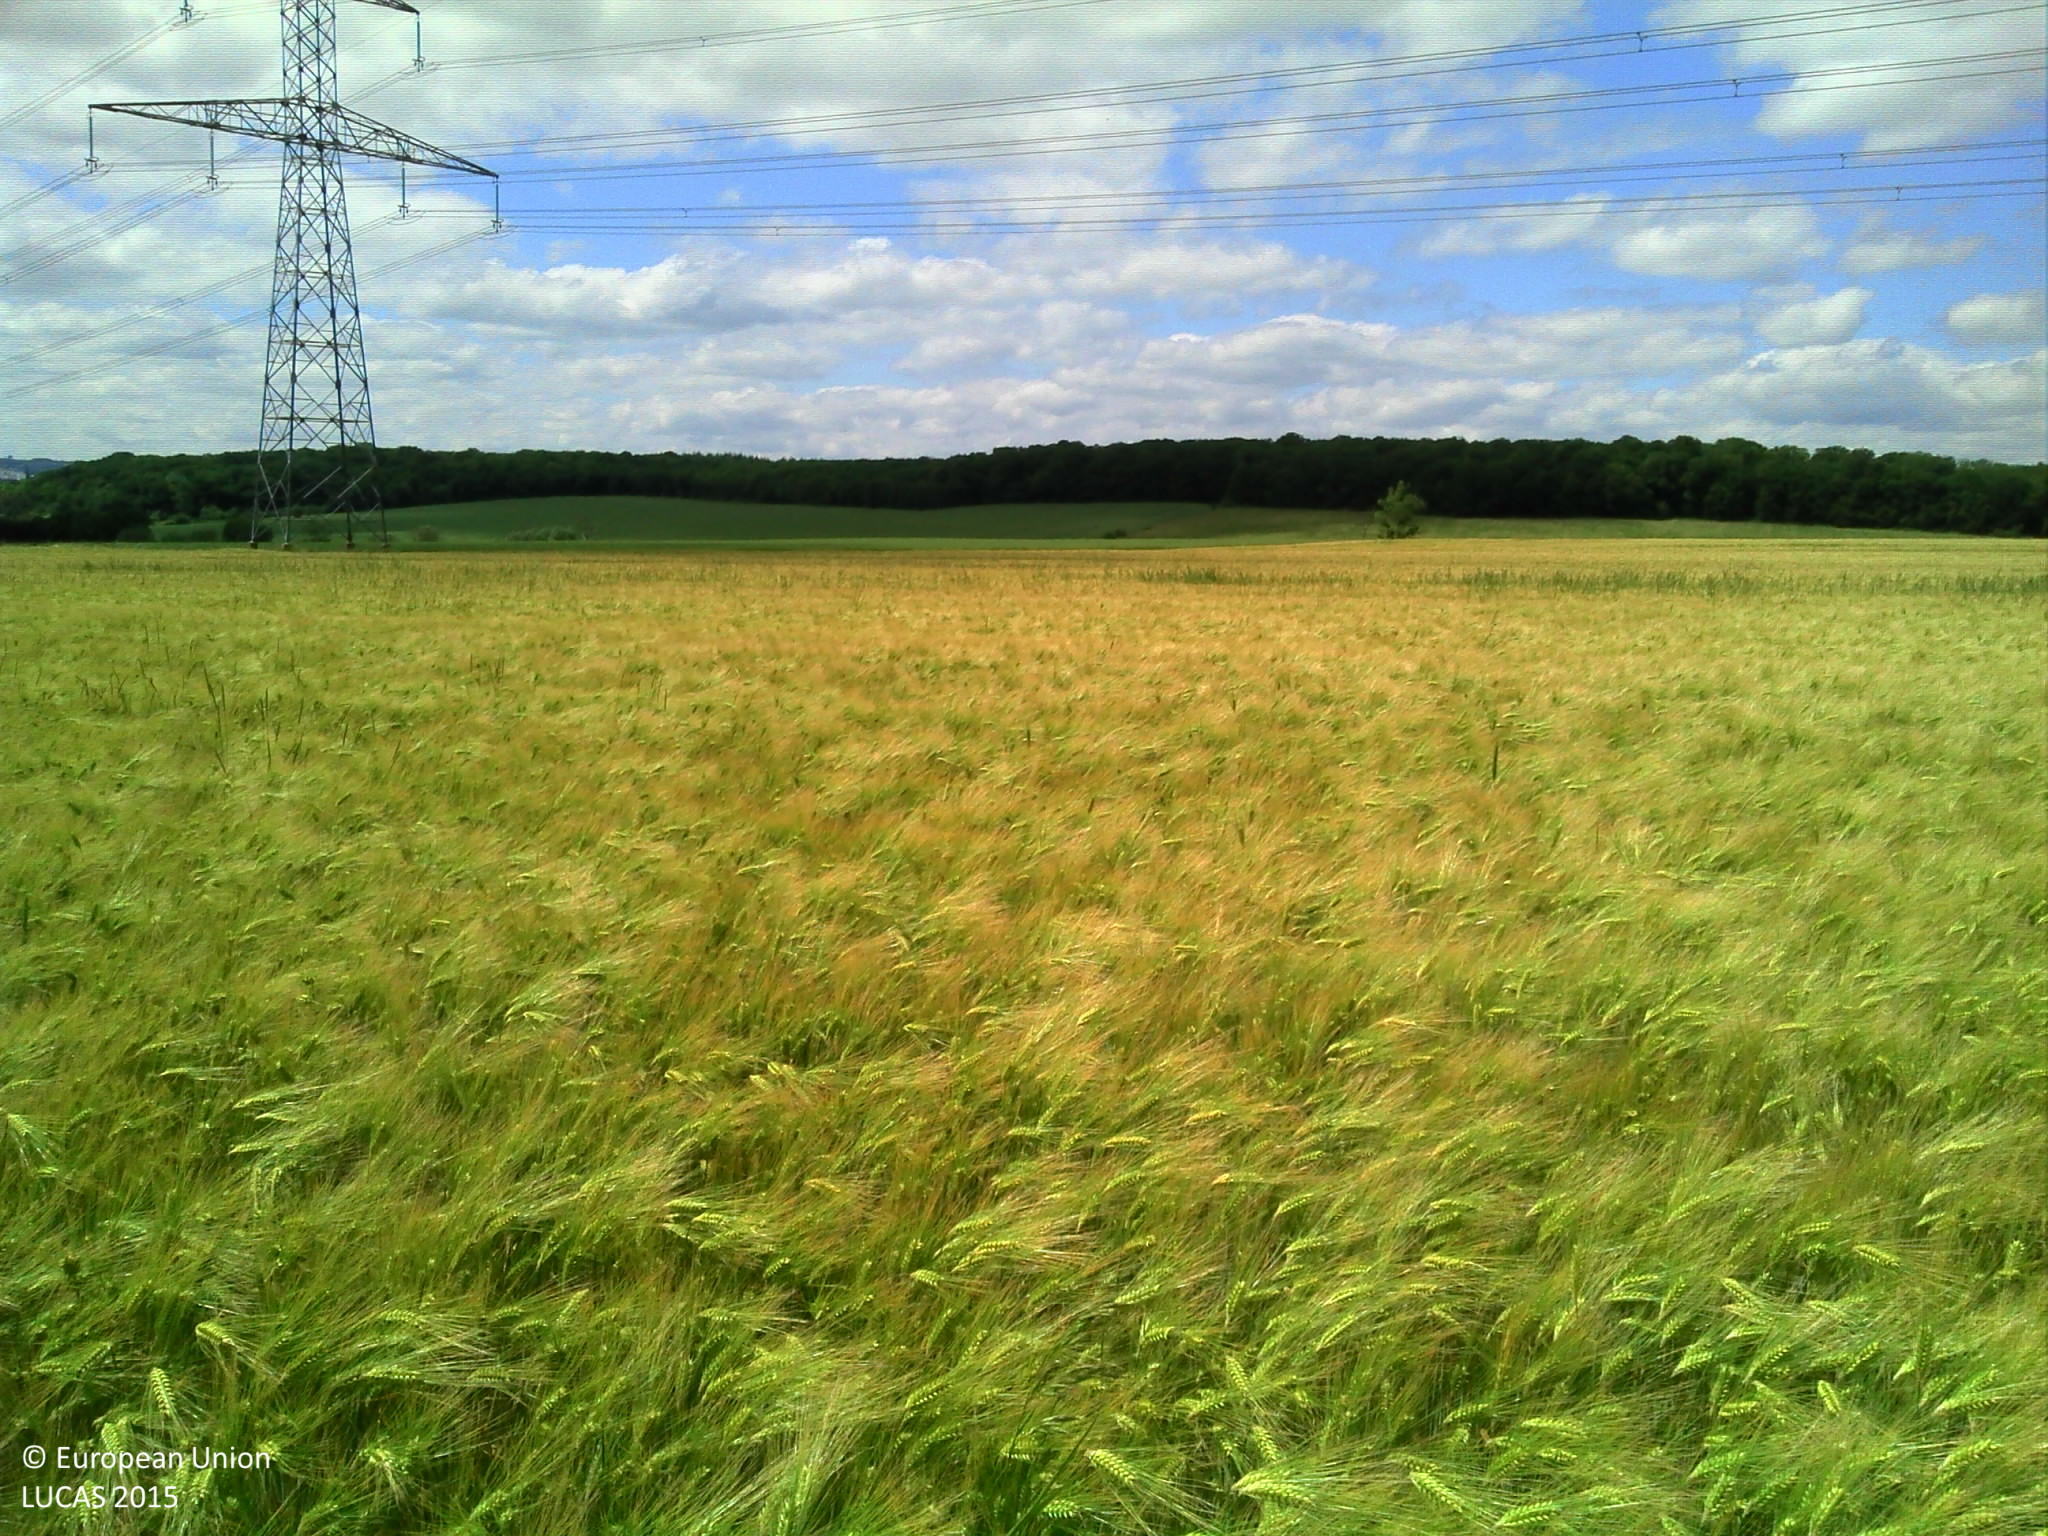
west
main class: Cropland
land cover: Barley
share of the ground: > 75 %
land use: Agriculture (excluding fallow land and kitchen gardens)
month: June
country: FR
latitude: 48.6647
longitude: 6.2662
